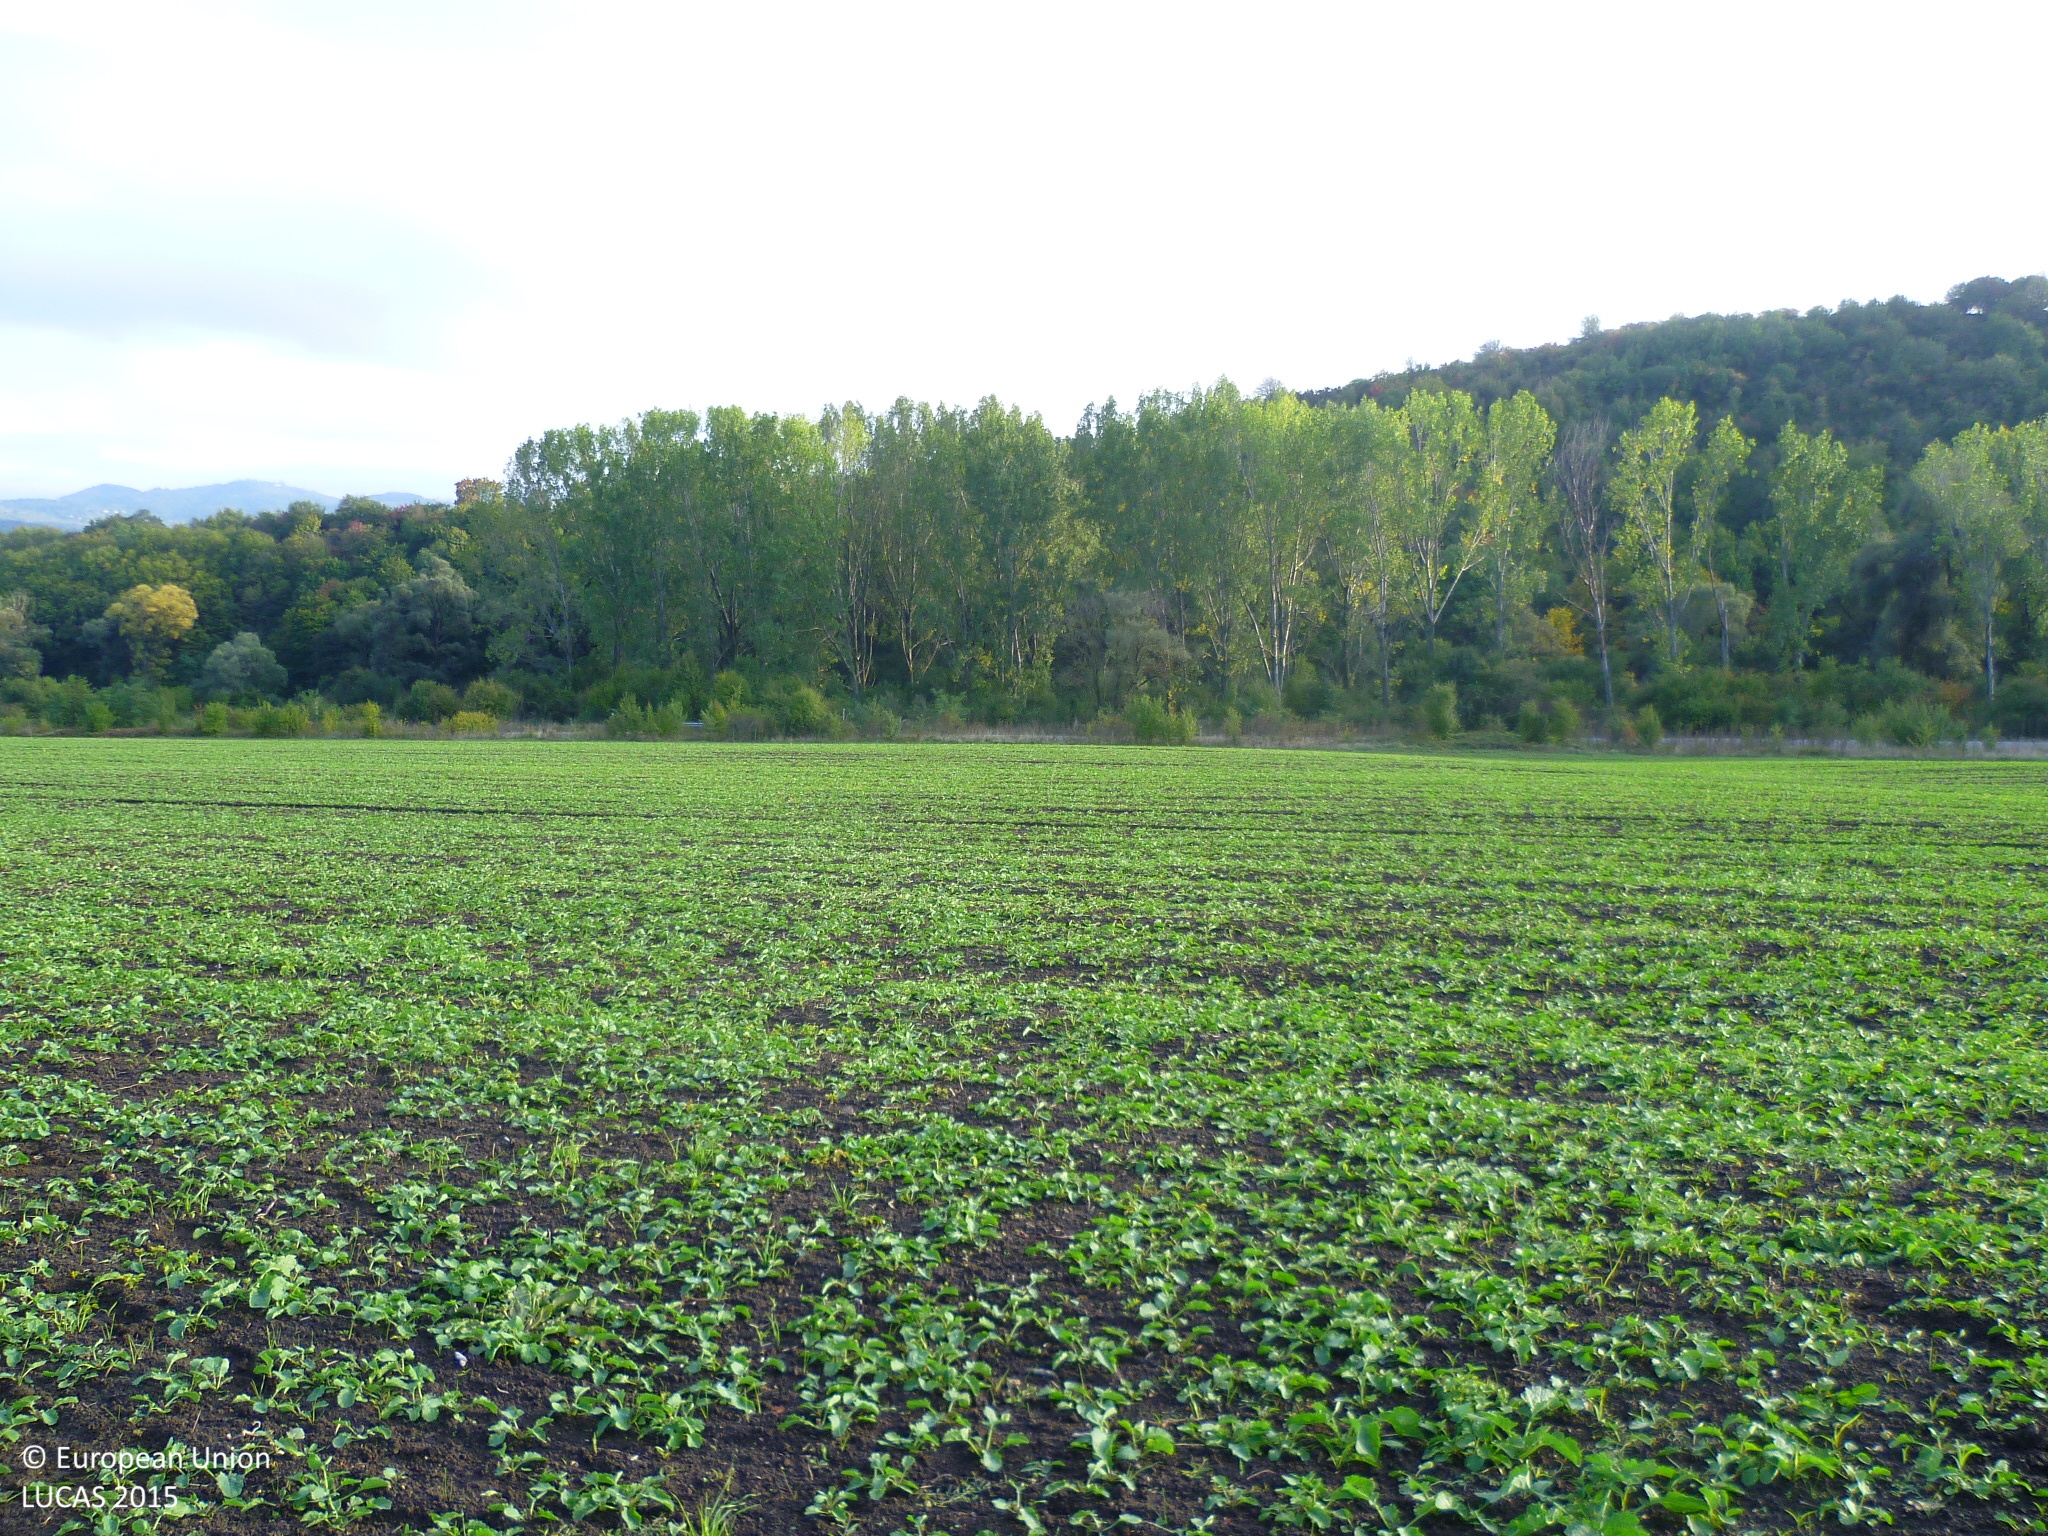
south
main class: Cropland
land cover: Rape and turnip rape
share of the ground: 50 - 75 %
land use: Agriculture (excluding fallow land and kitchen gardens)
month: October
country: BG
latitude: 42.7596
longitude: 23.0196
